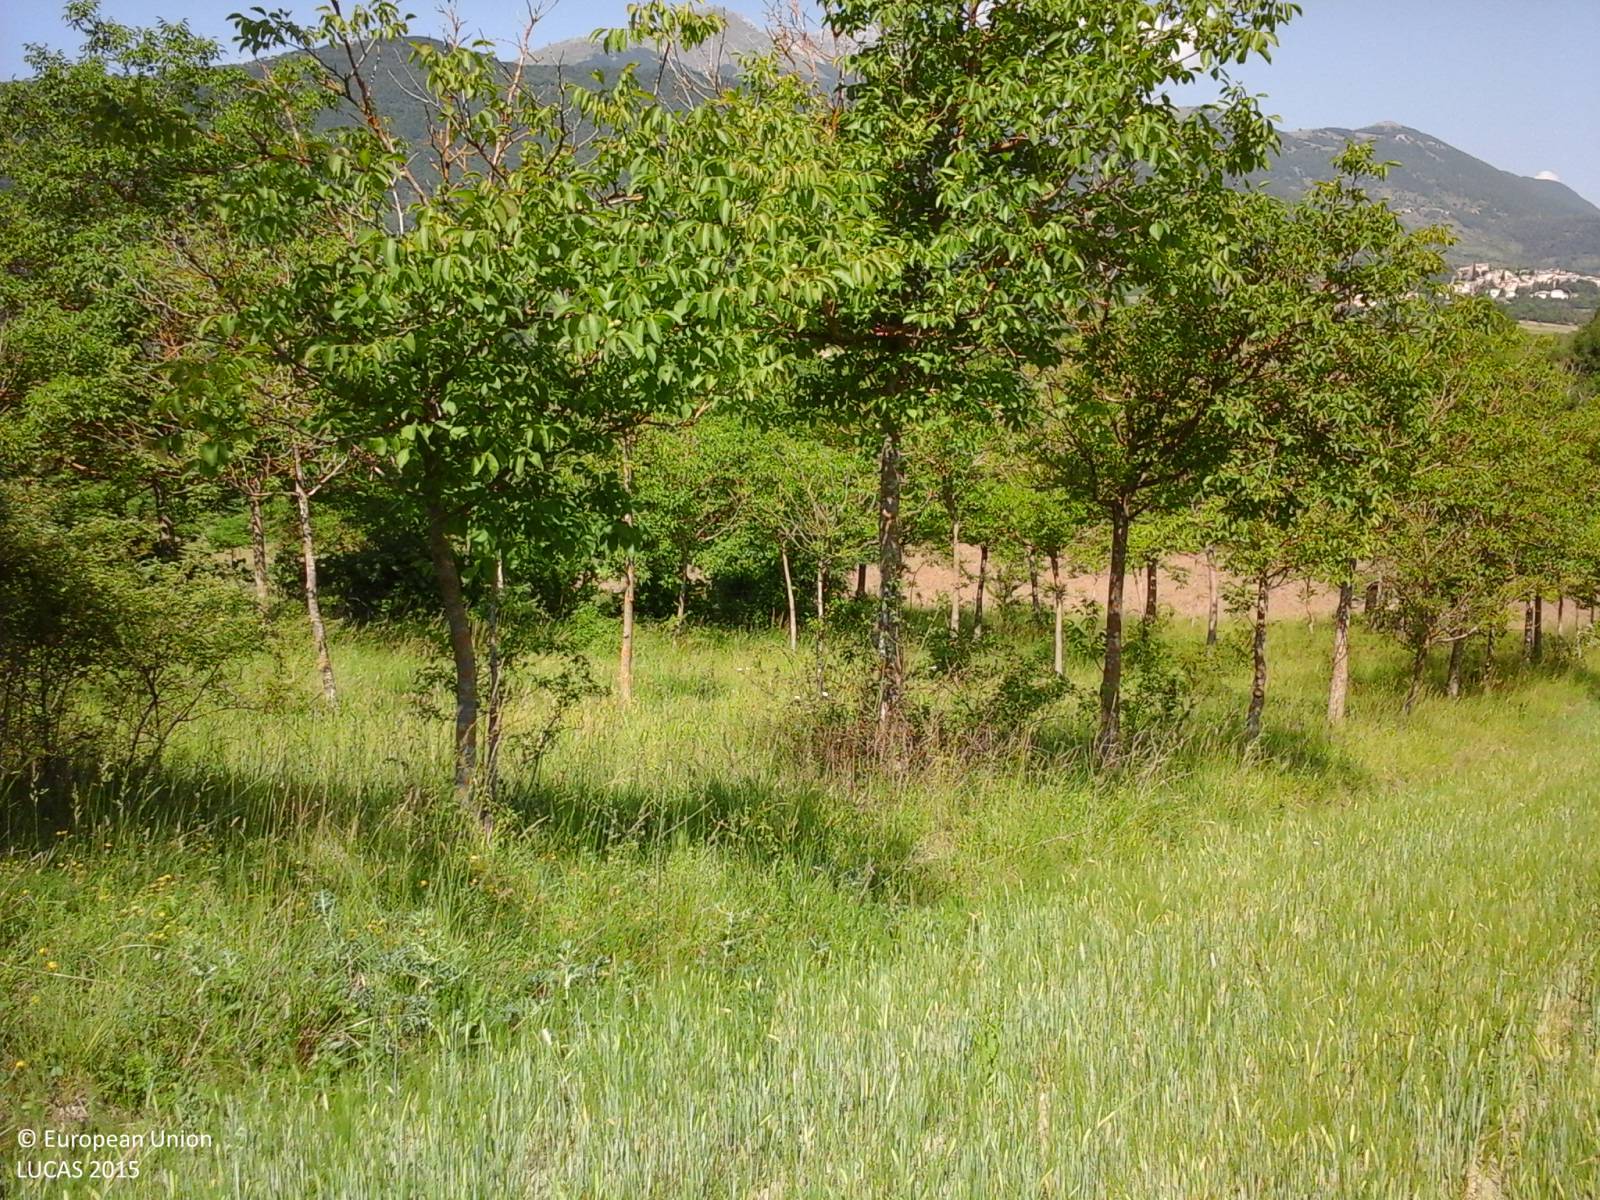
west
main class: Cropland
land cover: Barley
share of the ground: > 75 %
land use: Agriculture (excluding fallow land and kitchen gardens)
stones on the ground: < 10 %
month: June
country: IT
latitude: 42.1154
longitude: 13.7249
